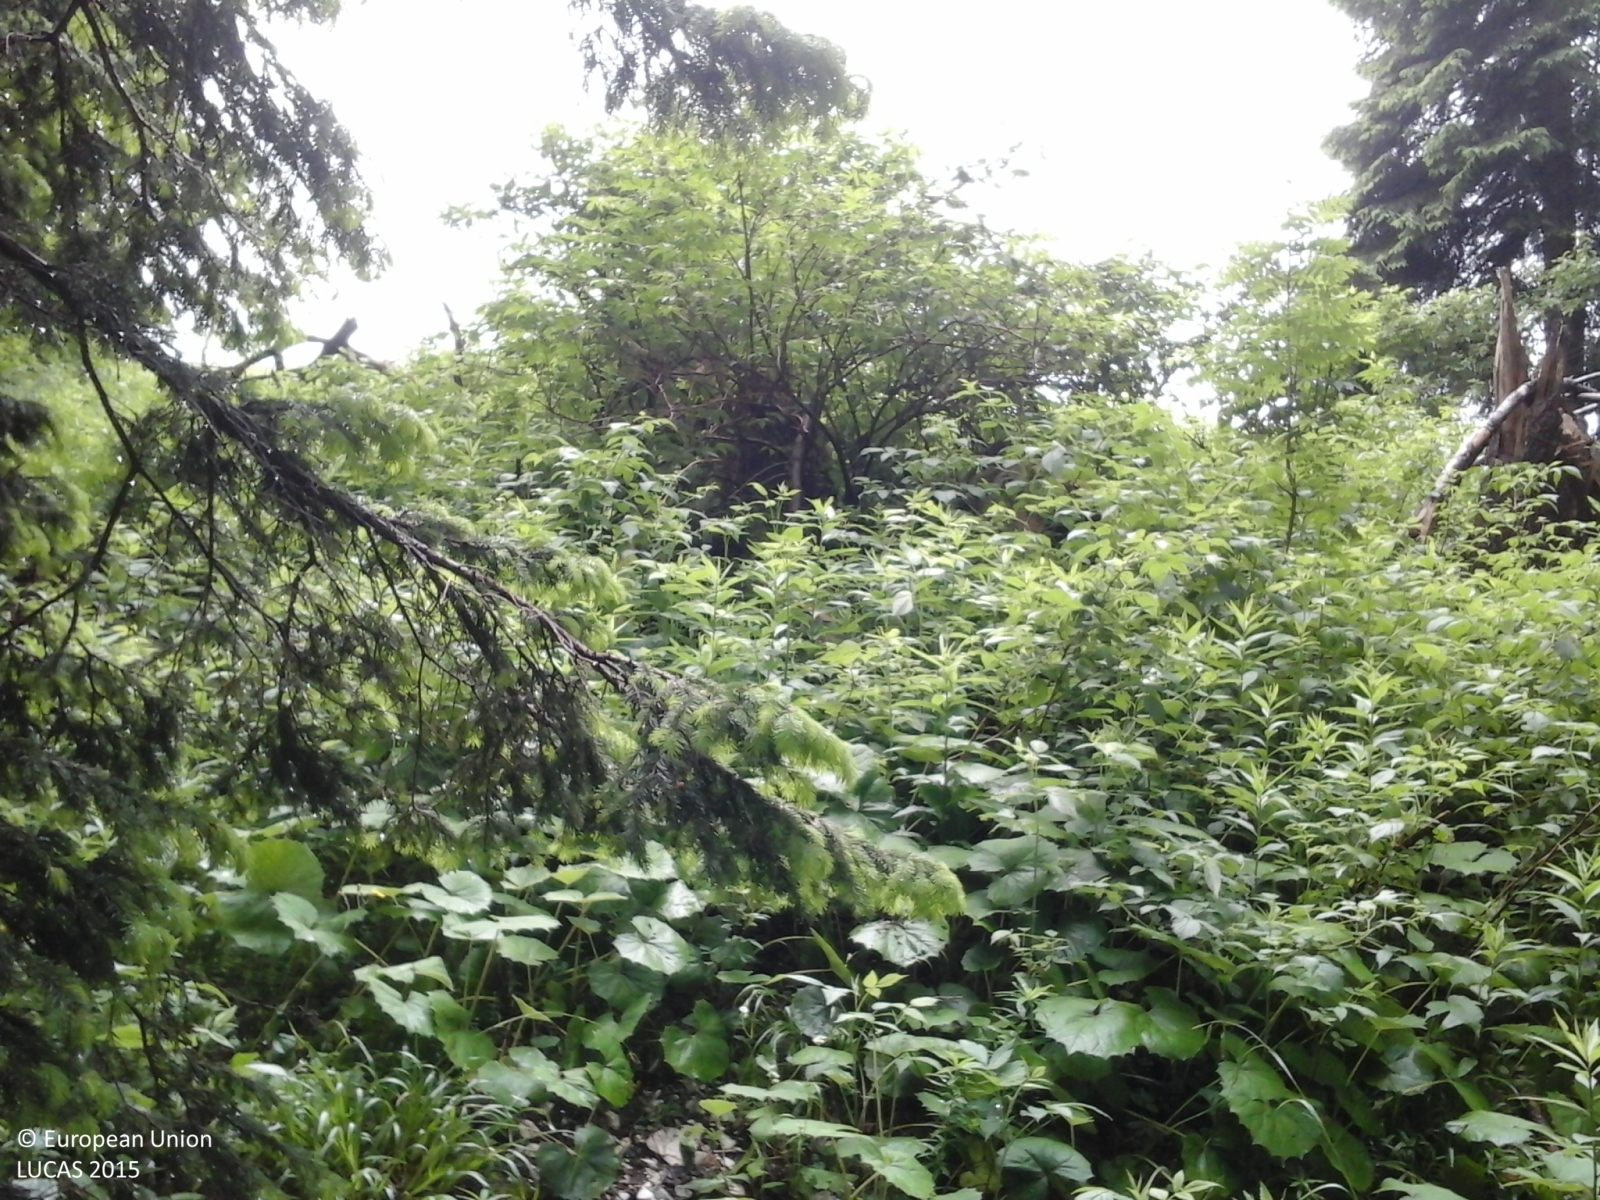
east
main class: Woodland
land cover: Spruce dominated coniferous woodland
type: alpine coniferous forest
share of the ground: > 75 %
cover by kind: coniferous forest trees 100 %
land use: Forestry
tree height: > 5 m
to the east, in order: Spruce dominated coniferous woodland; Fences; Spruce dominated coniferous woodland; Tracks; Grassland without tree/shrub cover; Spruce dominated coniferous woodland; Spruce dominated mixed woodland; Spruce dominated coniferous woodland; Fences; Grassland without tree/shrub cover
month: June
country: IT
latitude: 45.9787
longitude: 11.6112
